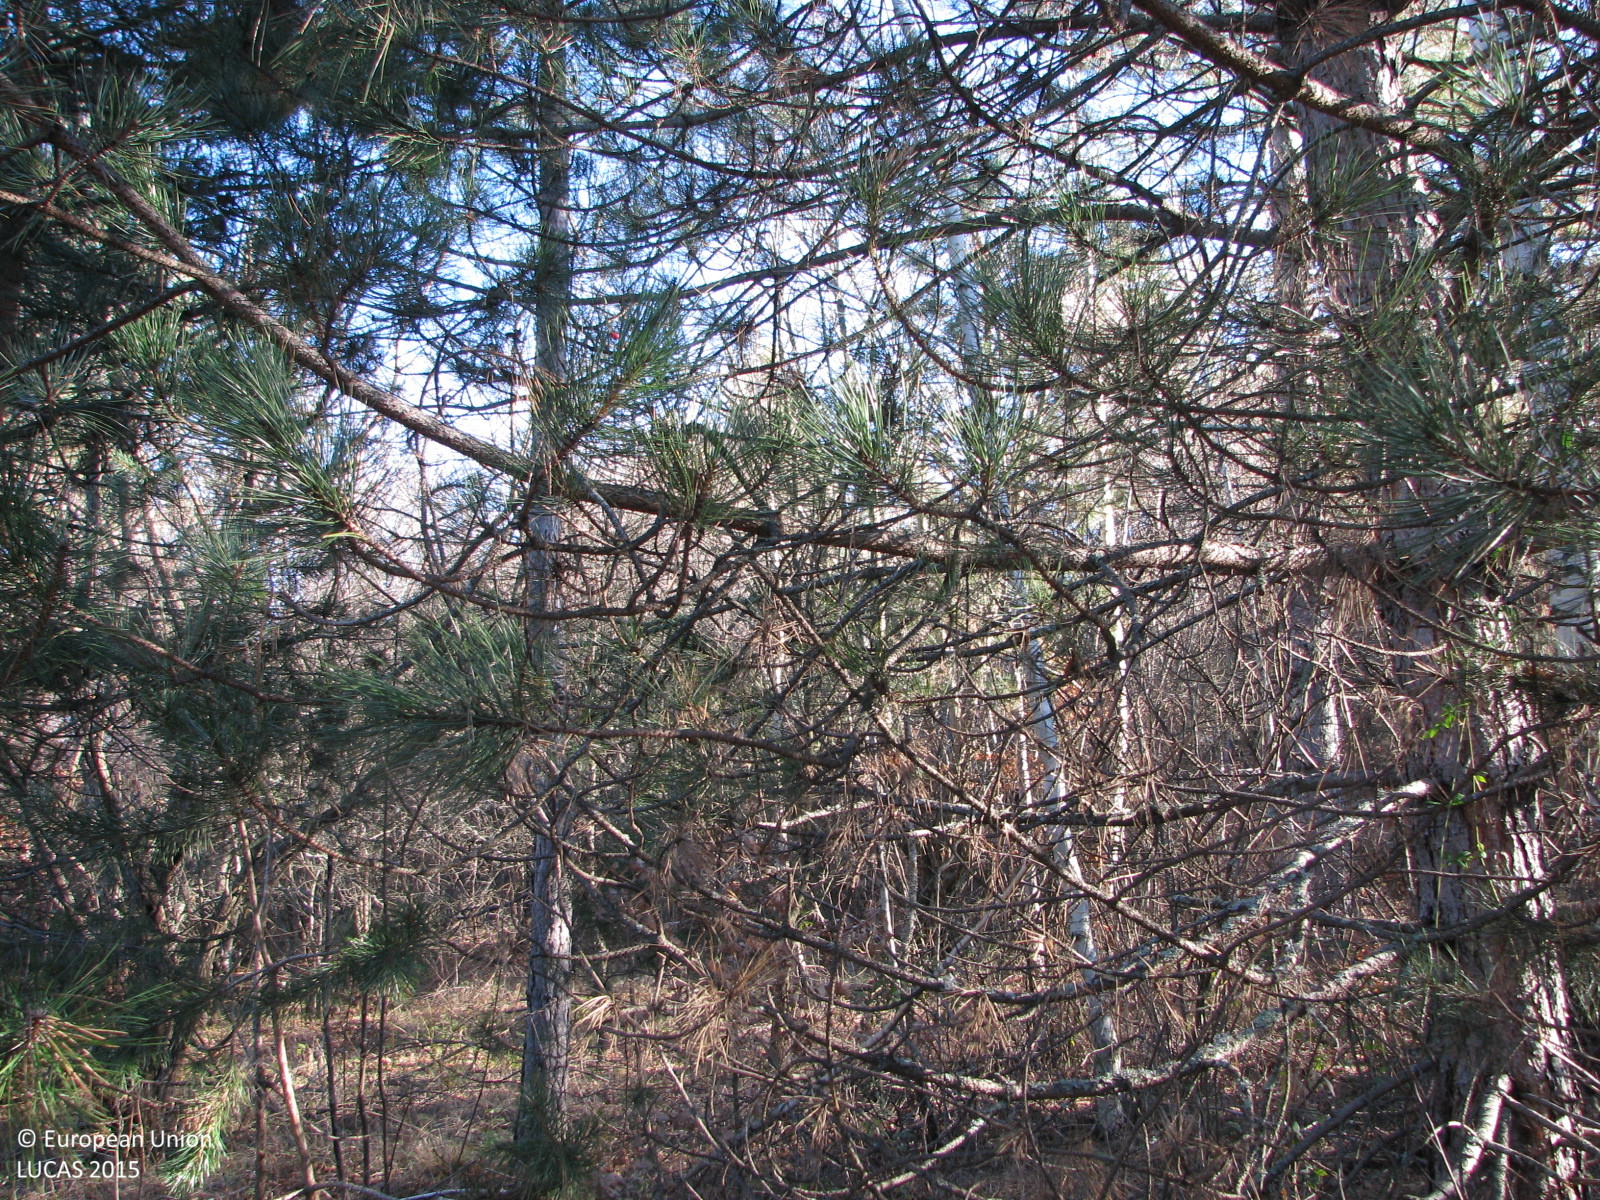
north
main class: Woodland
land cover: Pine dominated mixed woodland
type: hemiboreal forest and nemoral coniferous forest and mixed broadleaved-coniferous forest
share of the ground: > 75 %
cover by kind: coniferous forest trees 60 %, broadleaved forest trees 20 %, herbaceous plants 15 %, shrubs 5 %
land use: Forestry
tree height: > 5 m
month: December
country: BG
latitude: 42.4956
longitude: 25.0393
